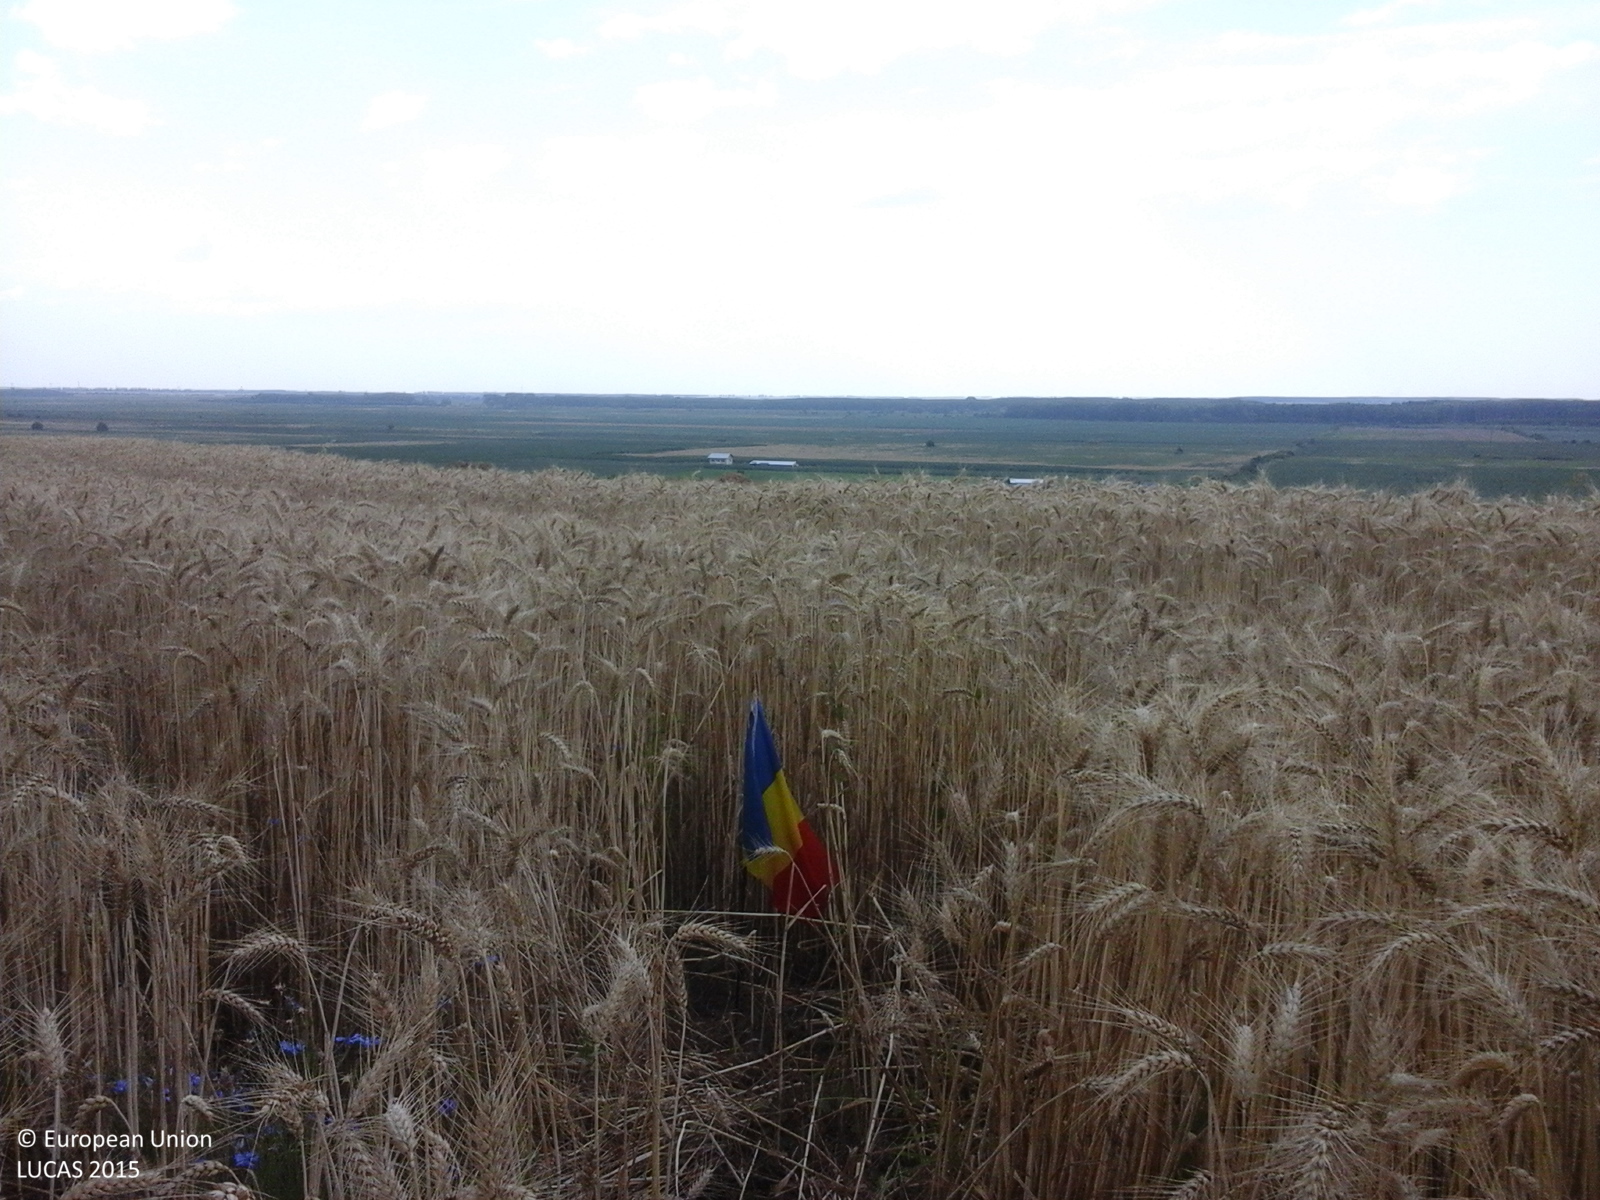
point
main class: Cropland
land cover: Common wheat
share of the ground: > 75 %
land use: Agriculture (excluding fallow land and kitchen gardens)
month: June
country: RO
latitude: 44.1494
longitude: 26.5538
